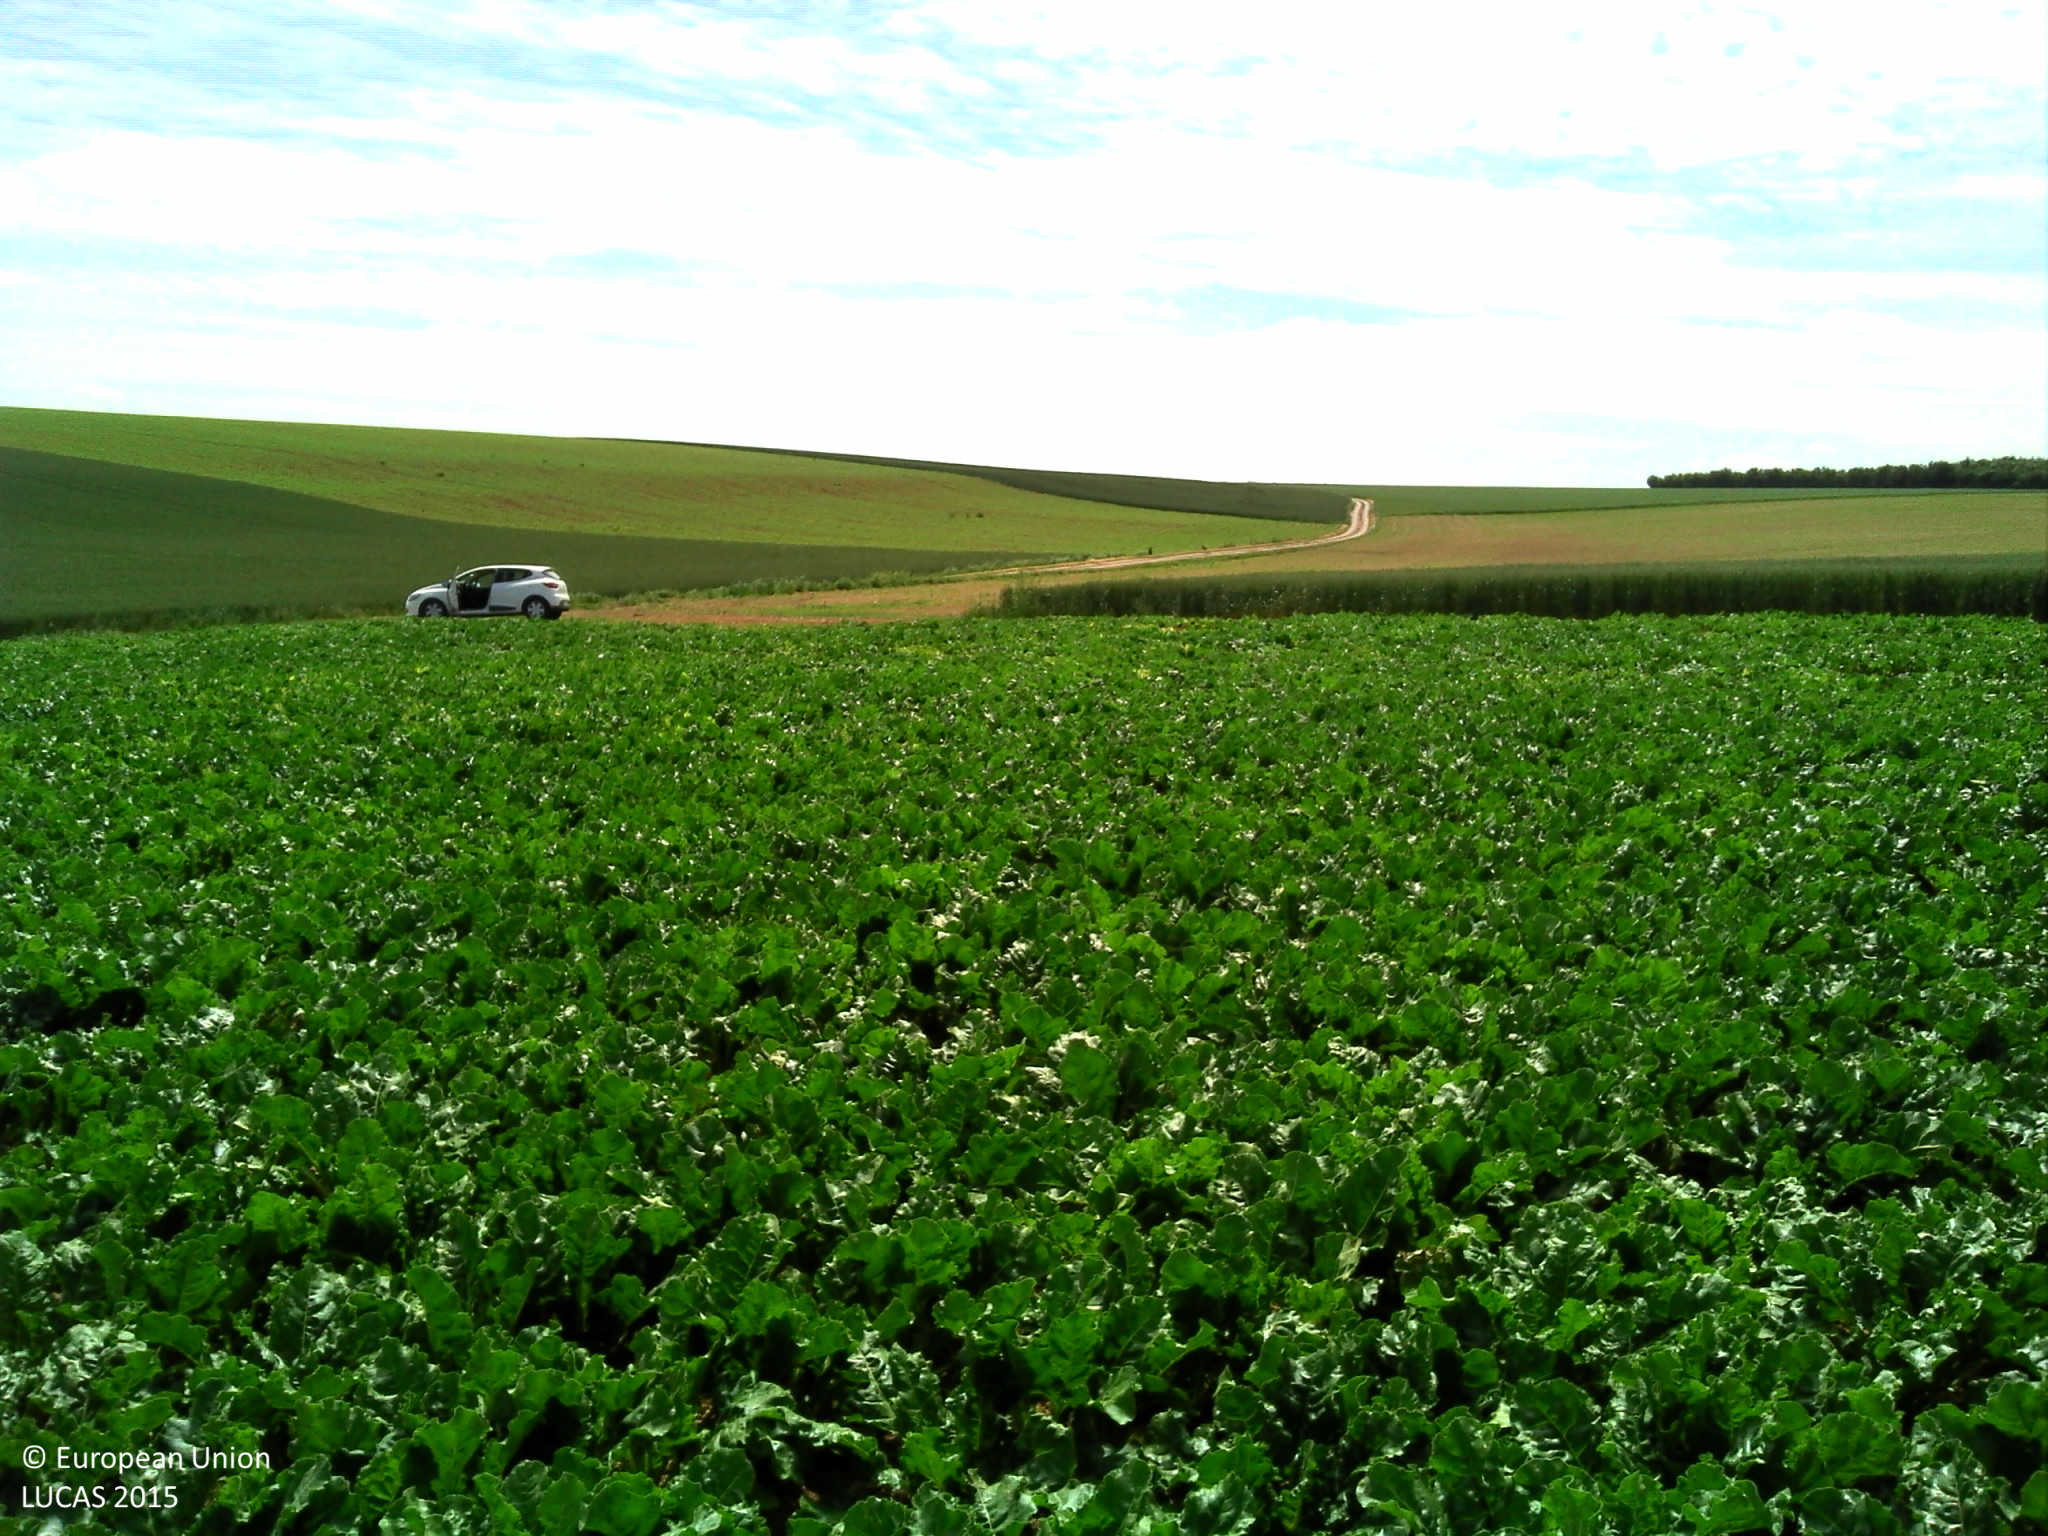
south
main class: Cropland
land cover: Sugar beet
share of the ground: > 75 %
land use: Agriculture (excluding fallow land and kitchen gardens)
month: June
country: FR
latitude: 50.7960
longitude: 2.1109
